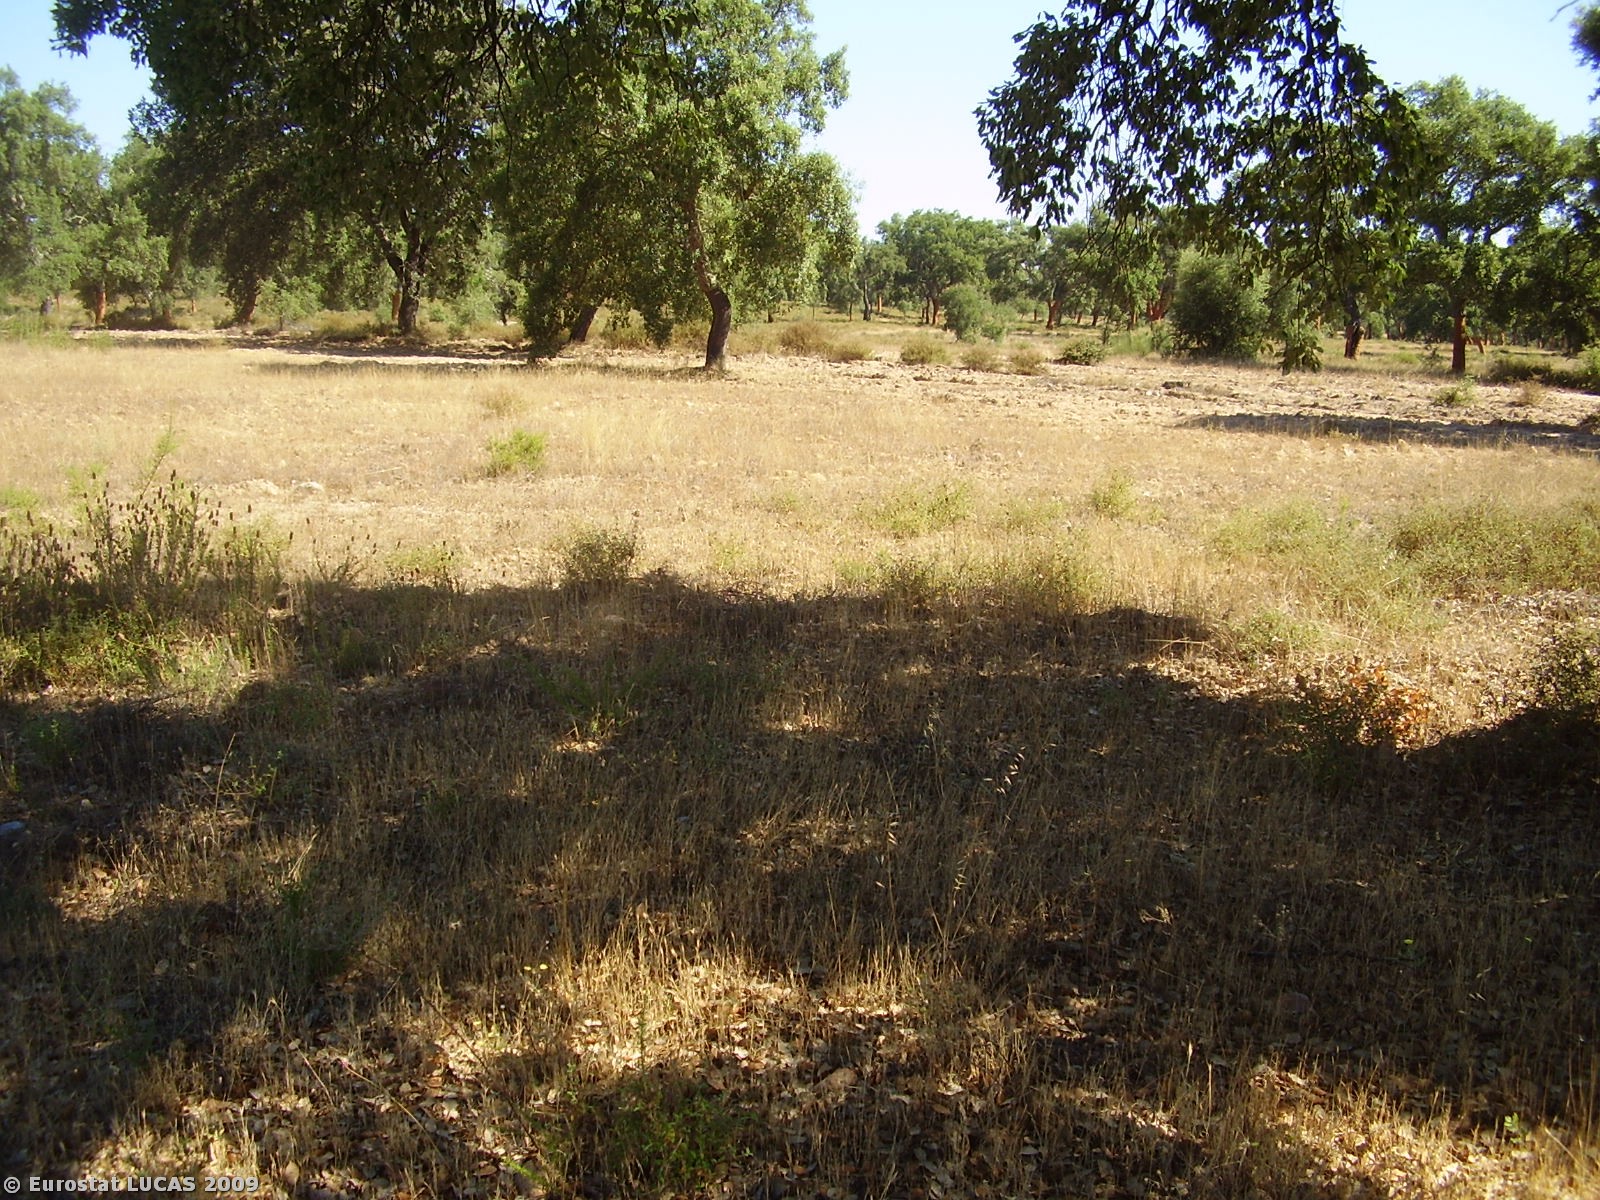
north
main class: Woodland
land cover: Broadleaved woodland
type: broadleaved evergreen forest
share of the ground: < 10 %
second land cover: Spontaneously vegetated surfaces
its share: > 75 %
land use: Forestry
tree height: > 5 m
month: July
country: PT
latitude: 39.3530
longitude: -8.1519
